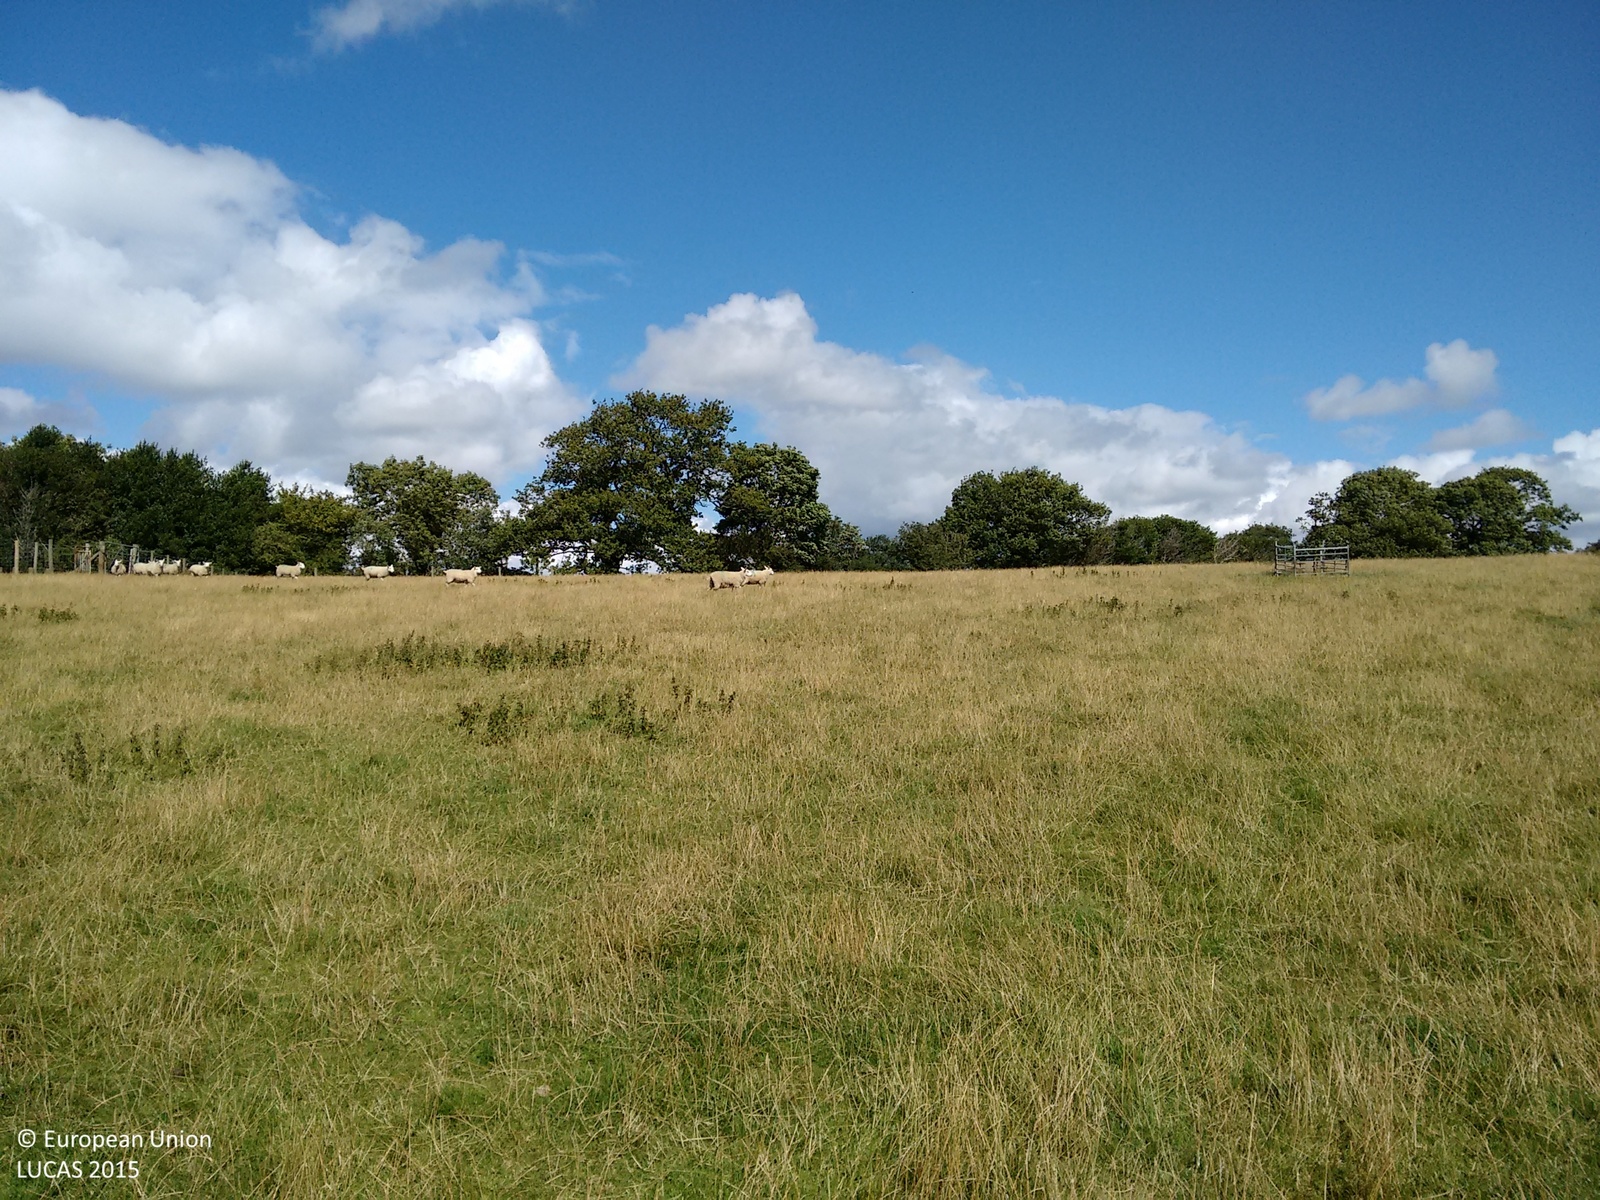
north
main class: Grassland
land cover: Grassland without tree/shrub cover
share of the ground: > 75 %
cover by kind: herbaceous plants 100 %
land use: Agriculture (excluding fallow land and kitchen gardens)
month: August
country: GB
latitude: 53.1701
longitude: -3.5027
